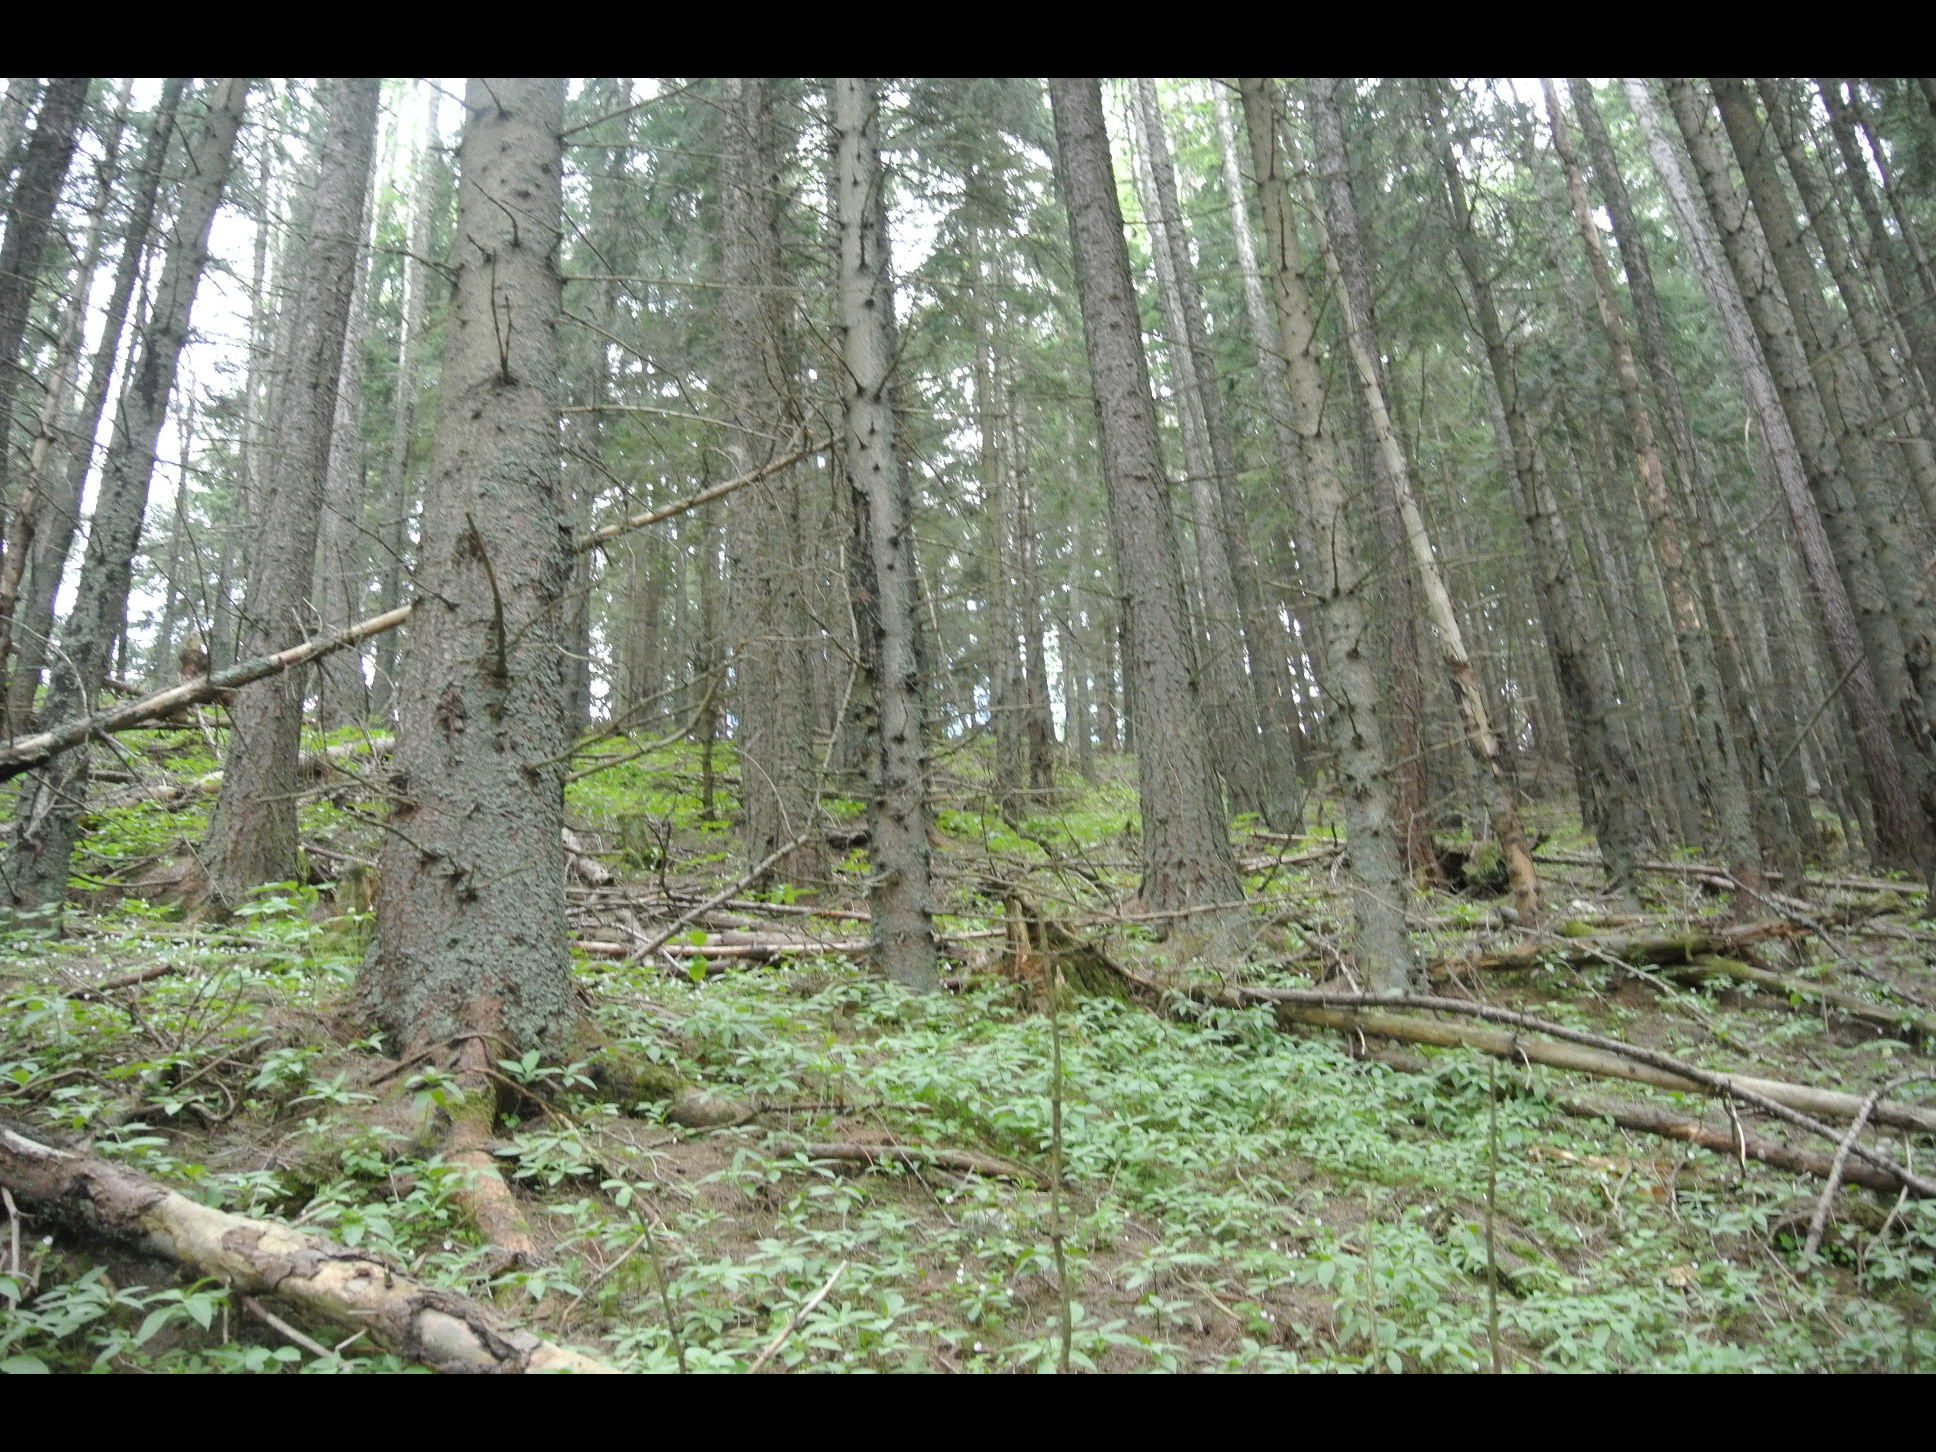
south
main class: Woodland
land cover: Spruce dominated coniferous woodland
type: alpine coniferous forest
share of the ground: > 75 %
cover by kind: coniferous forest trees 100 %
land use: Forestry
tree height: > 5 m
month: May
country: AT
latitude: 47.6576
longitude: 15.7673
